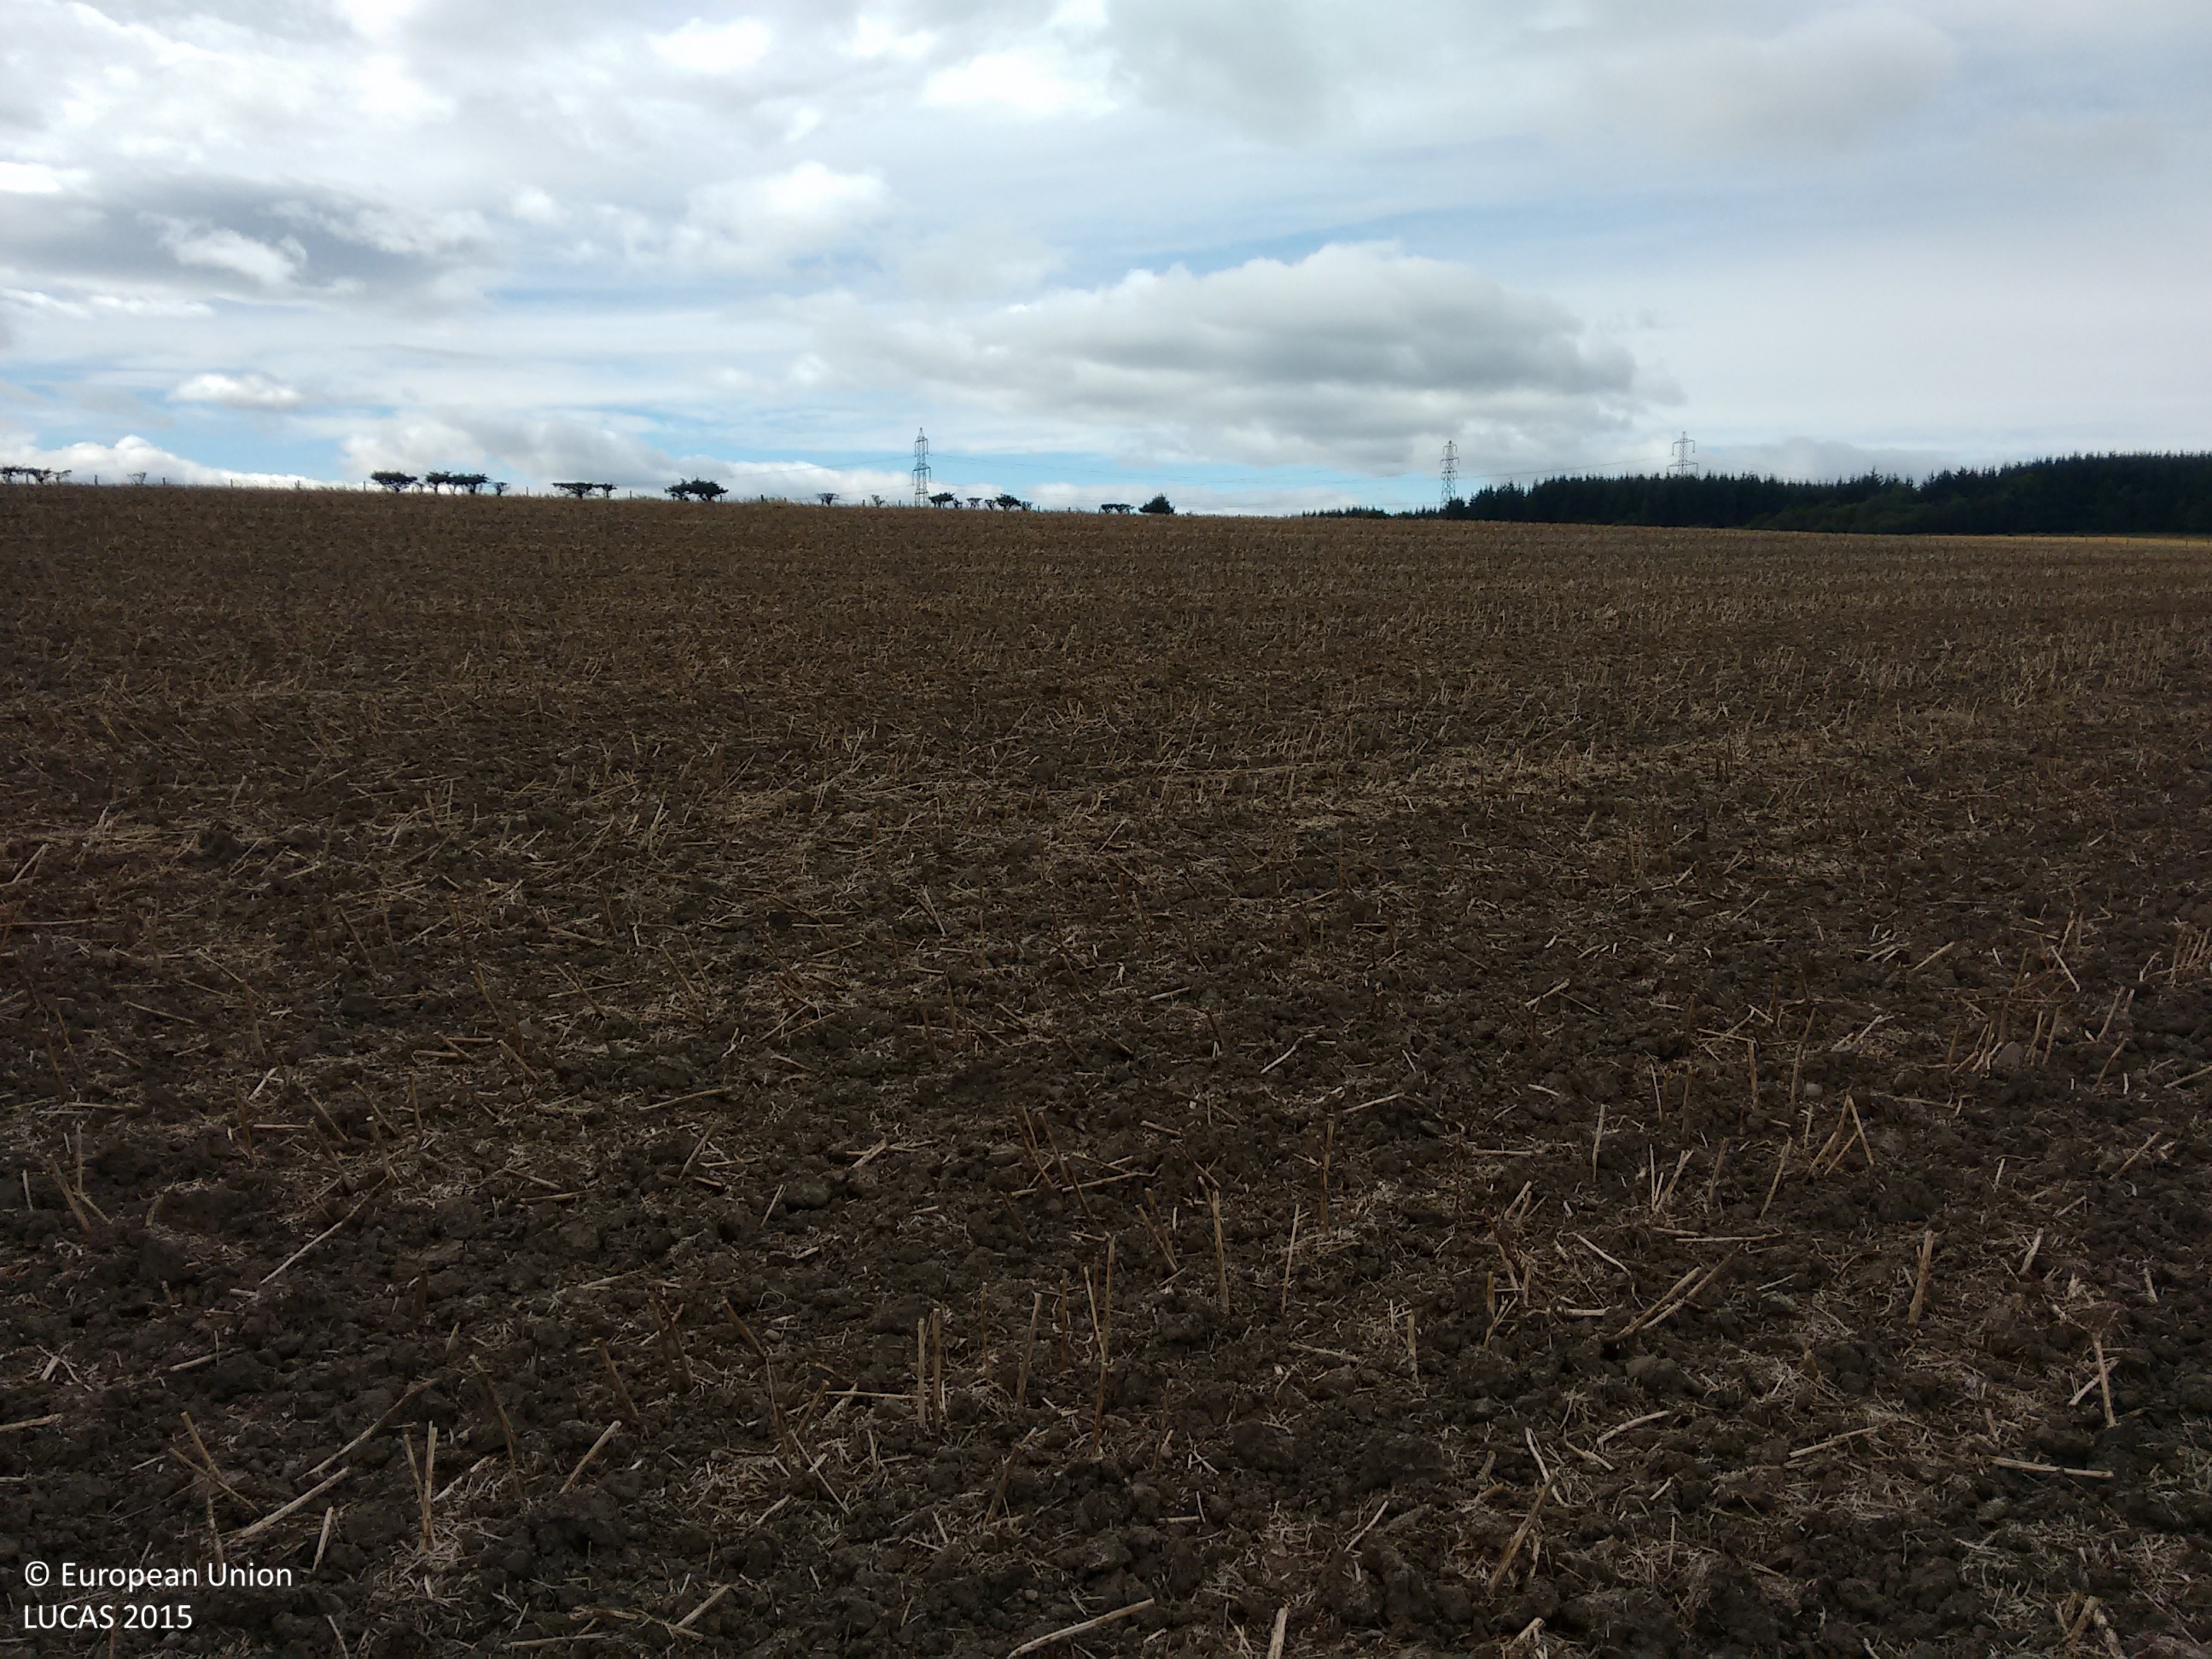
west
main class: Cropland
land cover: Rape and turnip rape
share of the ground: < 10 %
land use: Agriculture (excluding fallow land and kitchen gardens)
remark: Harvested field
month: September
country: GB
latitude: 56.0326
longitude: -3.8699
